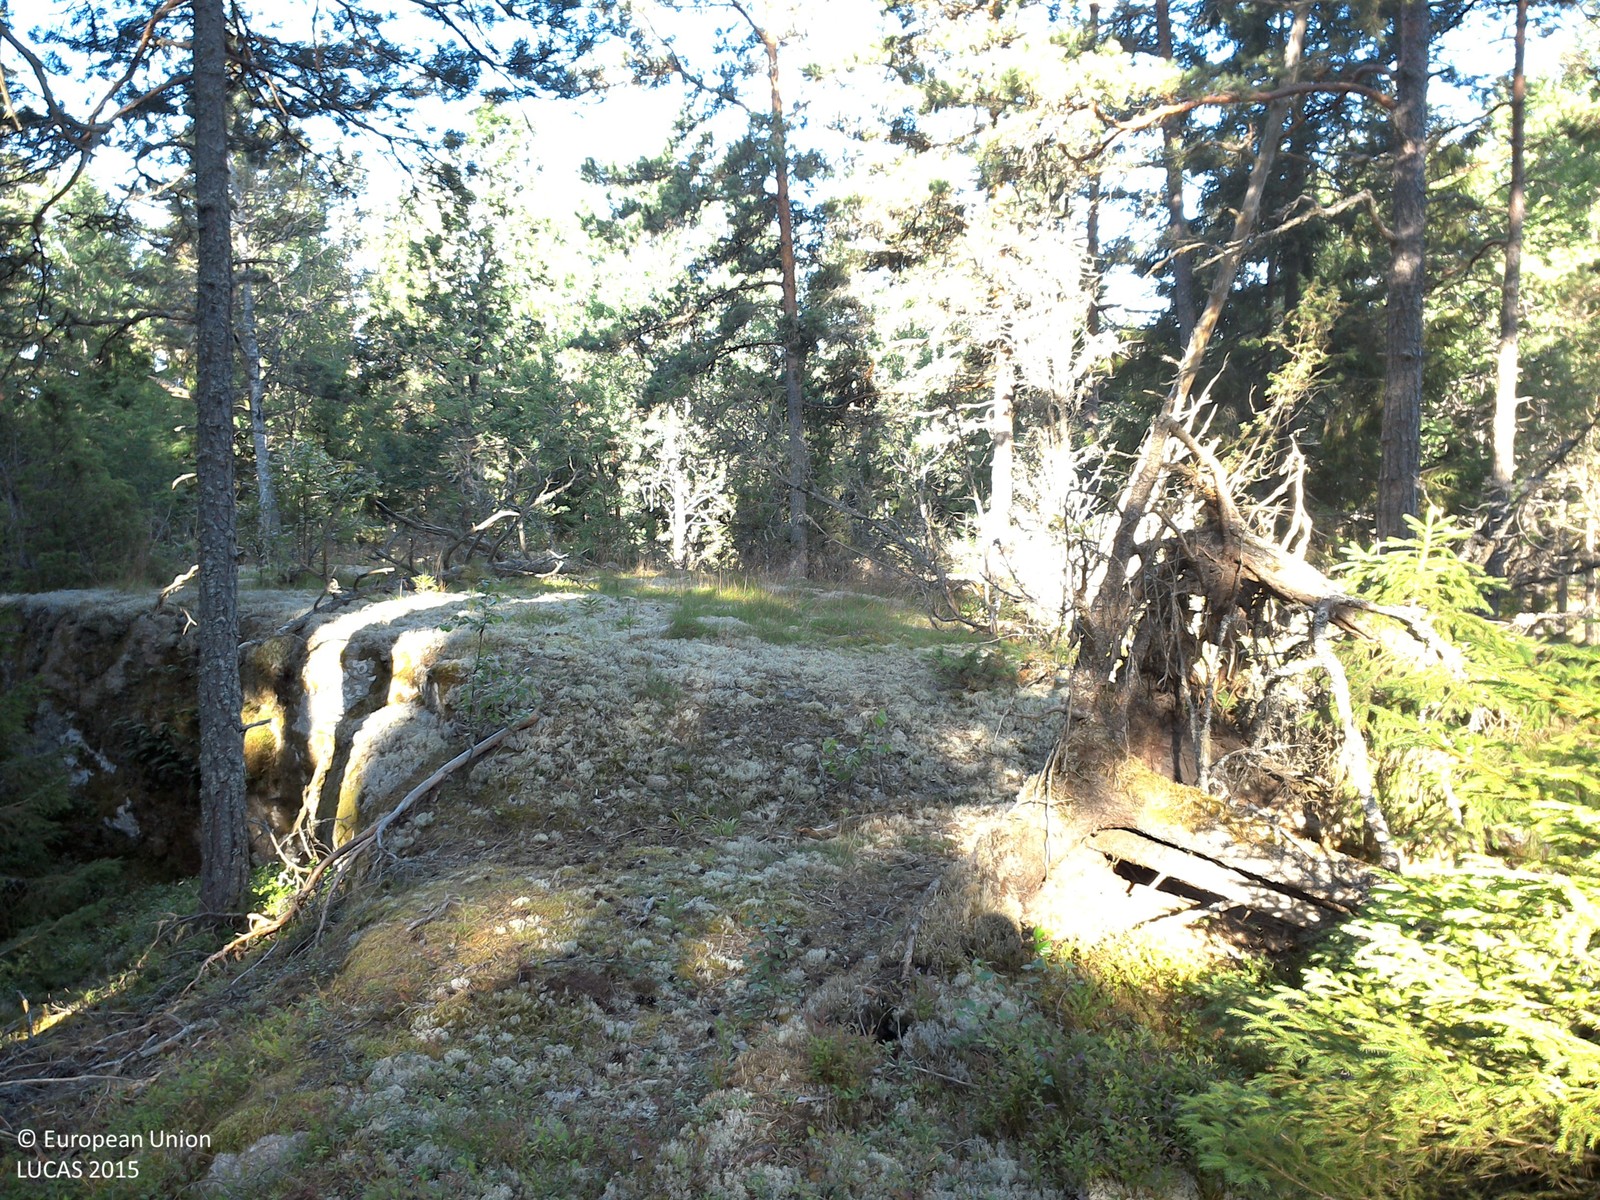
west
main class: Woodland
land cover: Pine dominated coniferous woodland
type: boreal forest
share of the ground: 50 - 75 %
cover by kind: coniferous forest trees 60 %, lichens and mosses 25 %, herbaceous plants 15 %
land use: Forestry
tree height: > 5 m
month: July
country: SE
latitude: 58.2402
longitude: 15.3262
